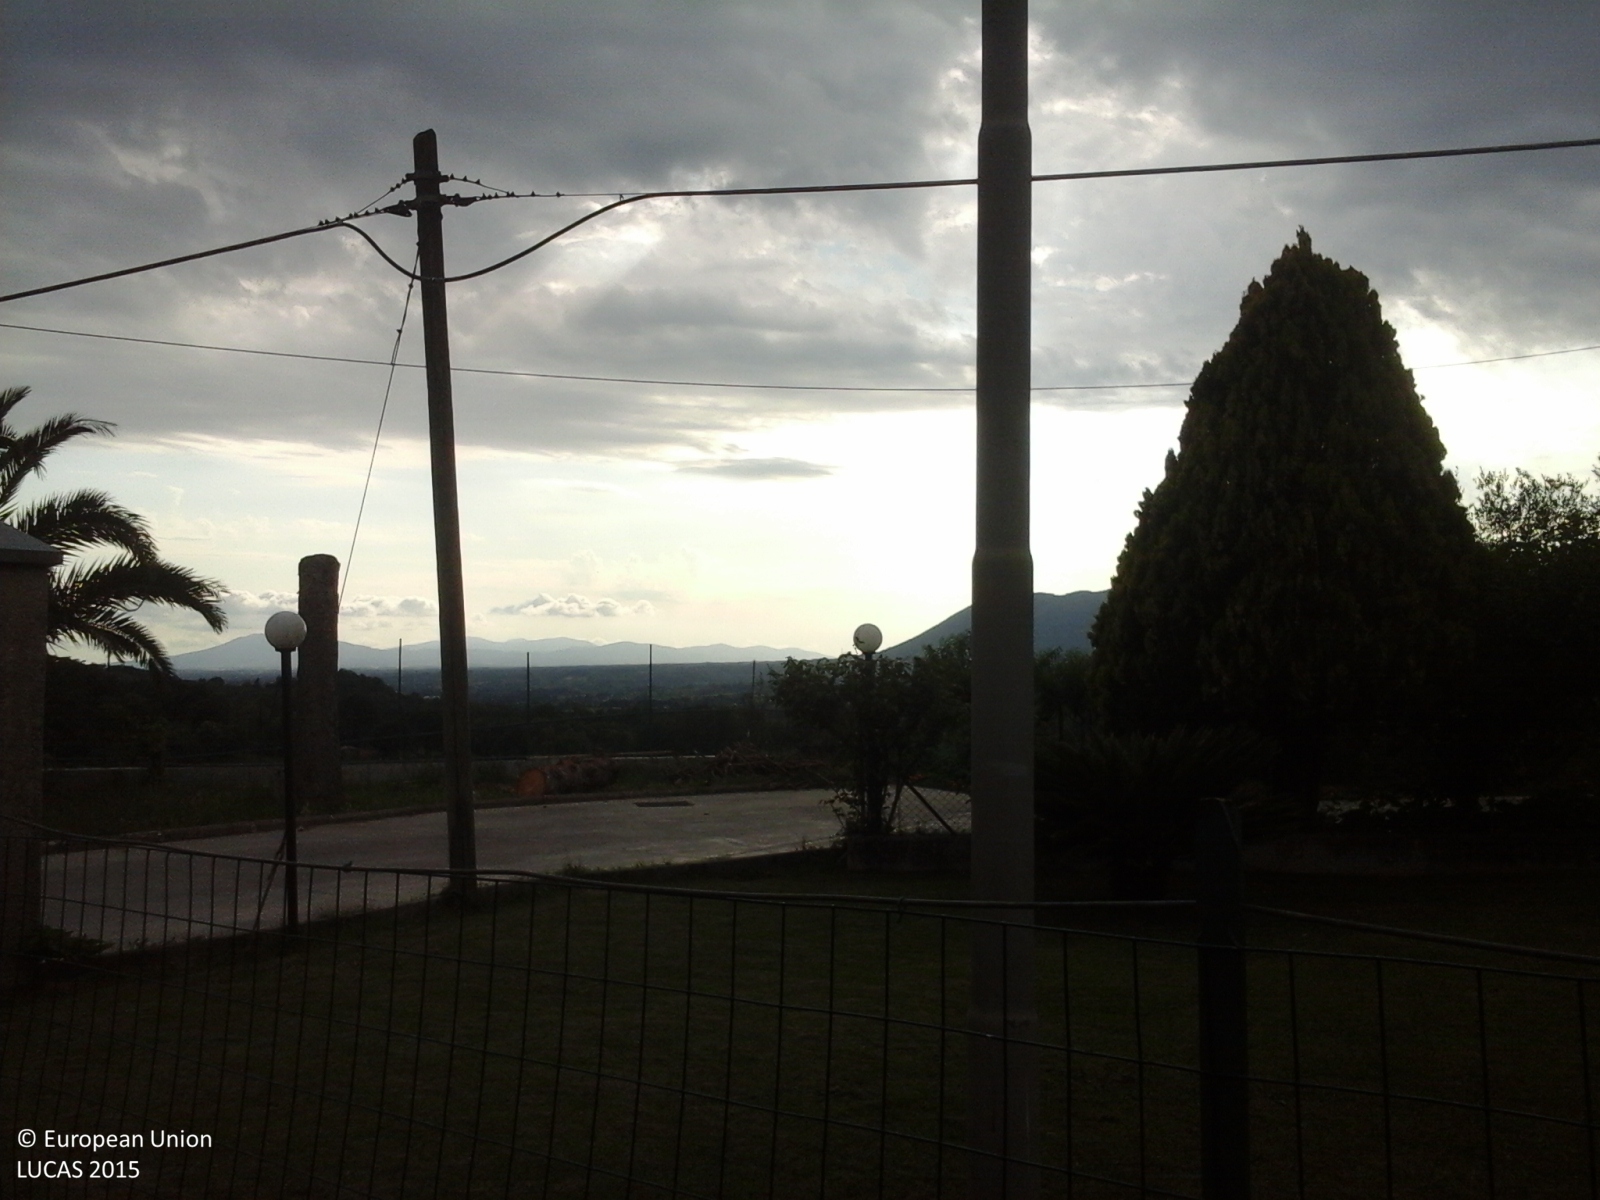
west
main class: Grassland
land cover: Grassland without tree/shrub cover
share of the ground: > 75 %
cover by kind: herbaceous plants 100 %
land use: Residential
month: June
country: IT
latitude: 41.8297
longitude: 13.0831
